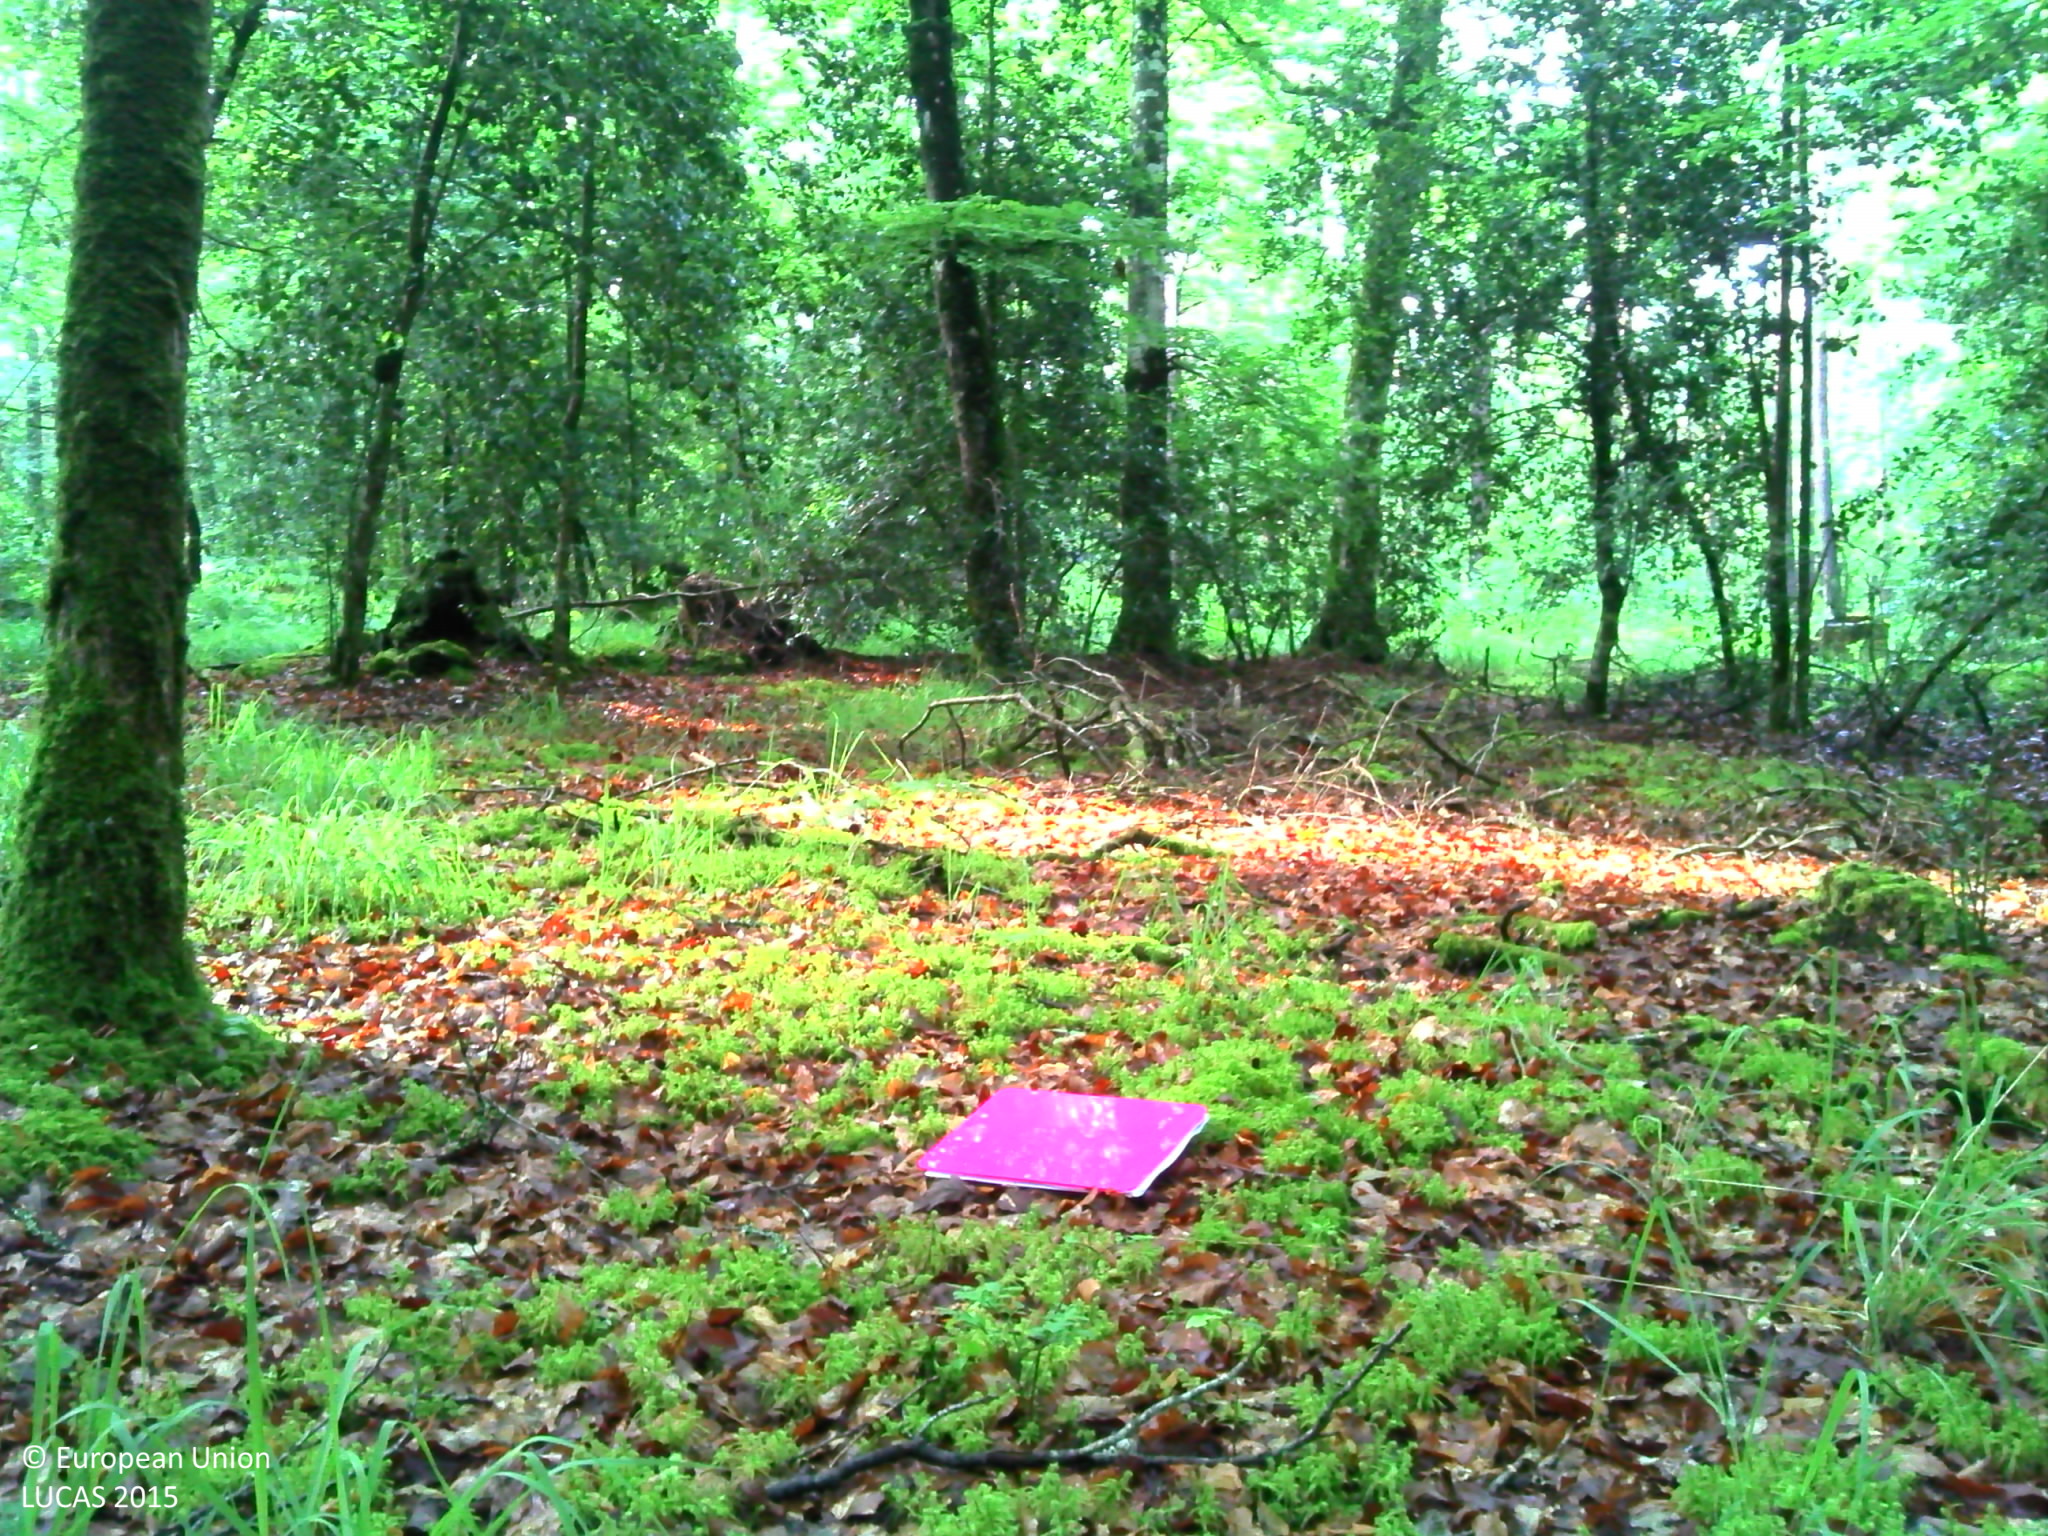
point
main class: Woodland
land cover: Broadleaved woodland
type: acidophilous oak and oak-birch forest
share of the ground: > 75 %
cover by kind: broadleaved forest trees 90 %, herbaceous plants 5 %, lichens and mosses 5 %
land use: Forestry
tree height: > 5 m
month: June
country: FR
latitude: 48.2752
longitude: -1.4857
